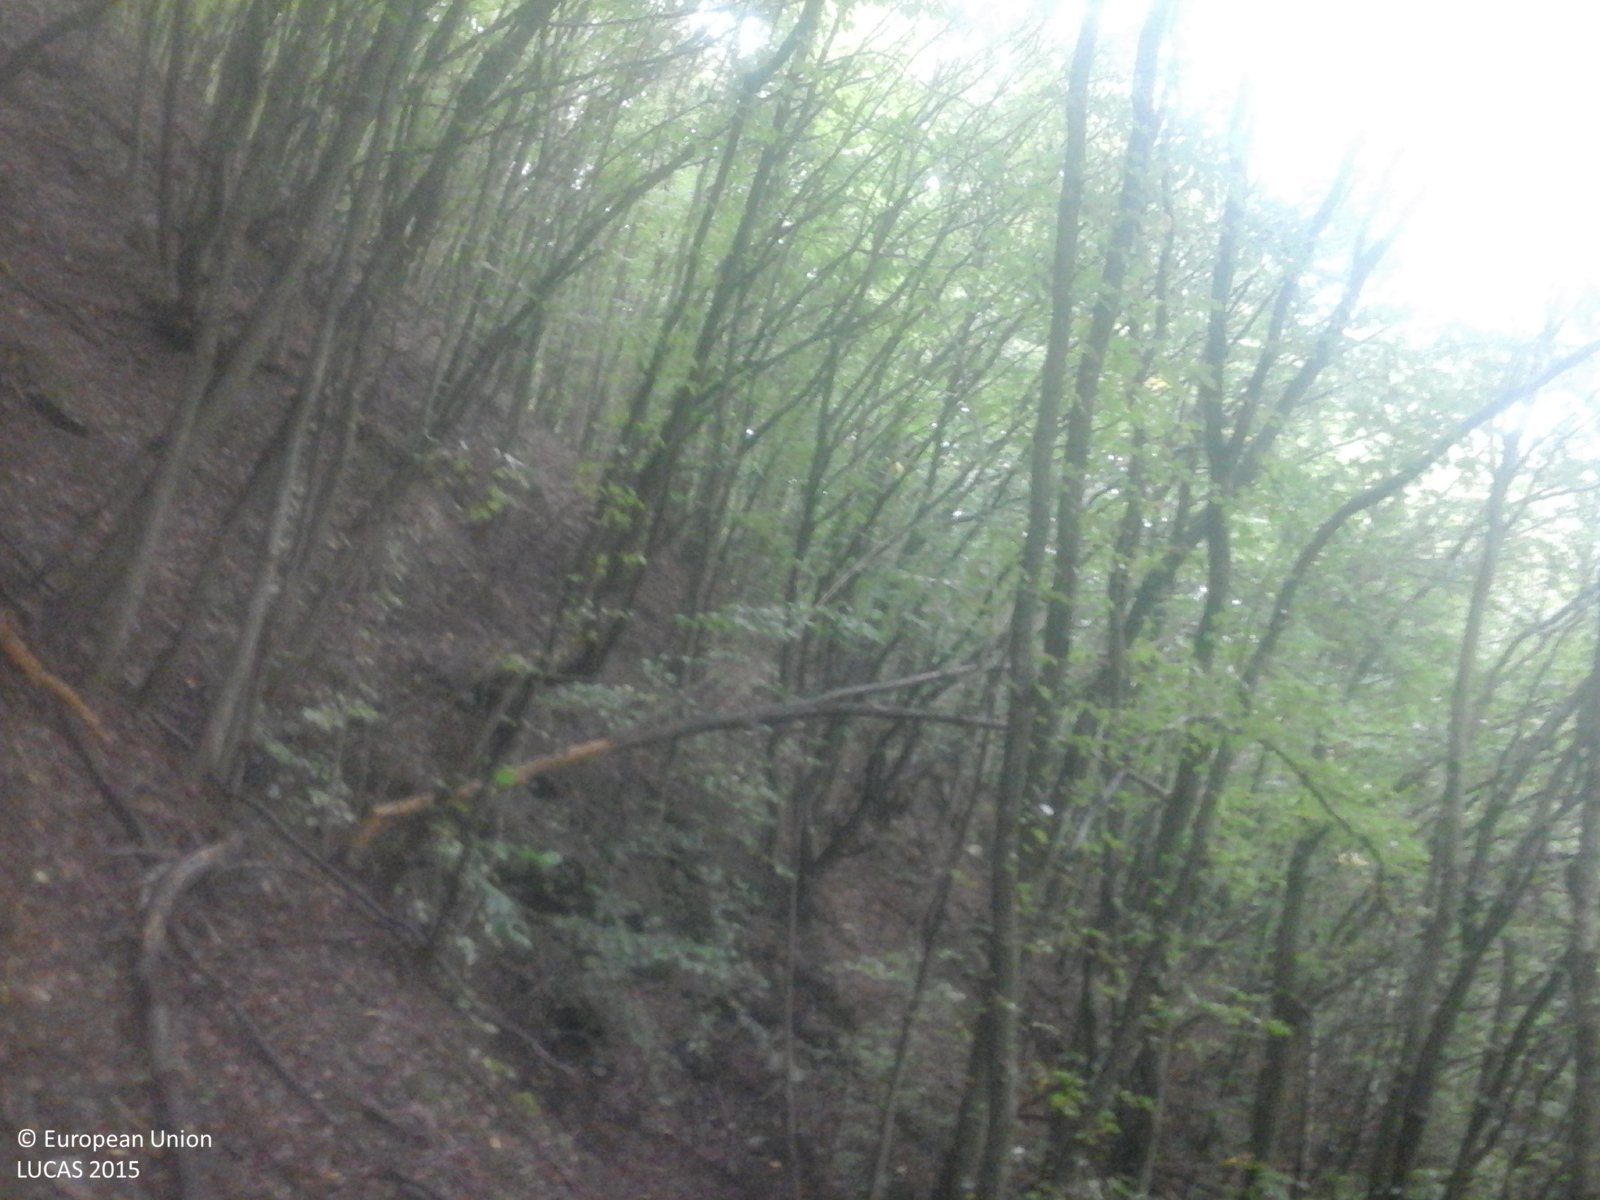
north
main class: Woodland
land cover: Broadleaved woodland
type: beech forest
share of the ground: > 75 %
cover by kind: broadleaved forest trees 100 %
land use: Forestry
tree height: > 5 m
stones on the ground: 10 - 25 %
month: September
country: RO
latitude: 45.8299
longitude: 23.6994
